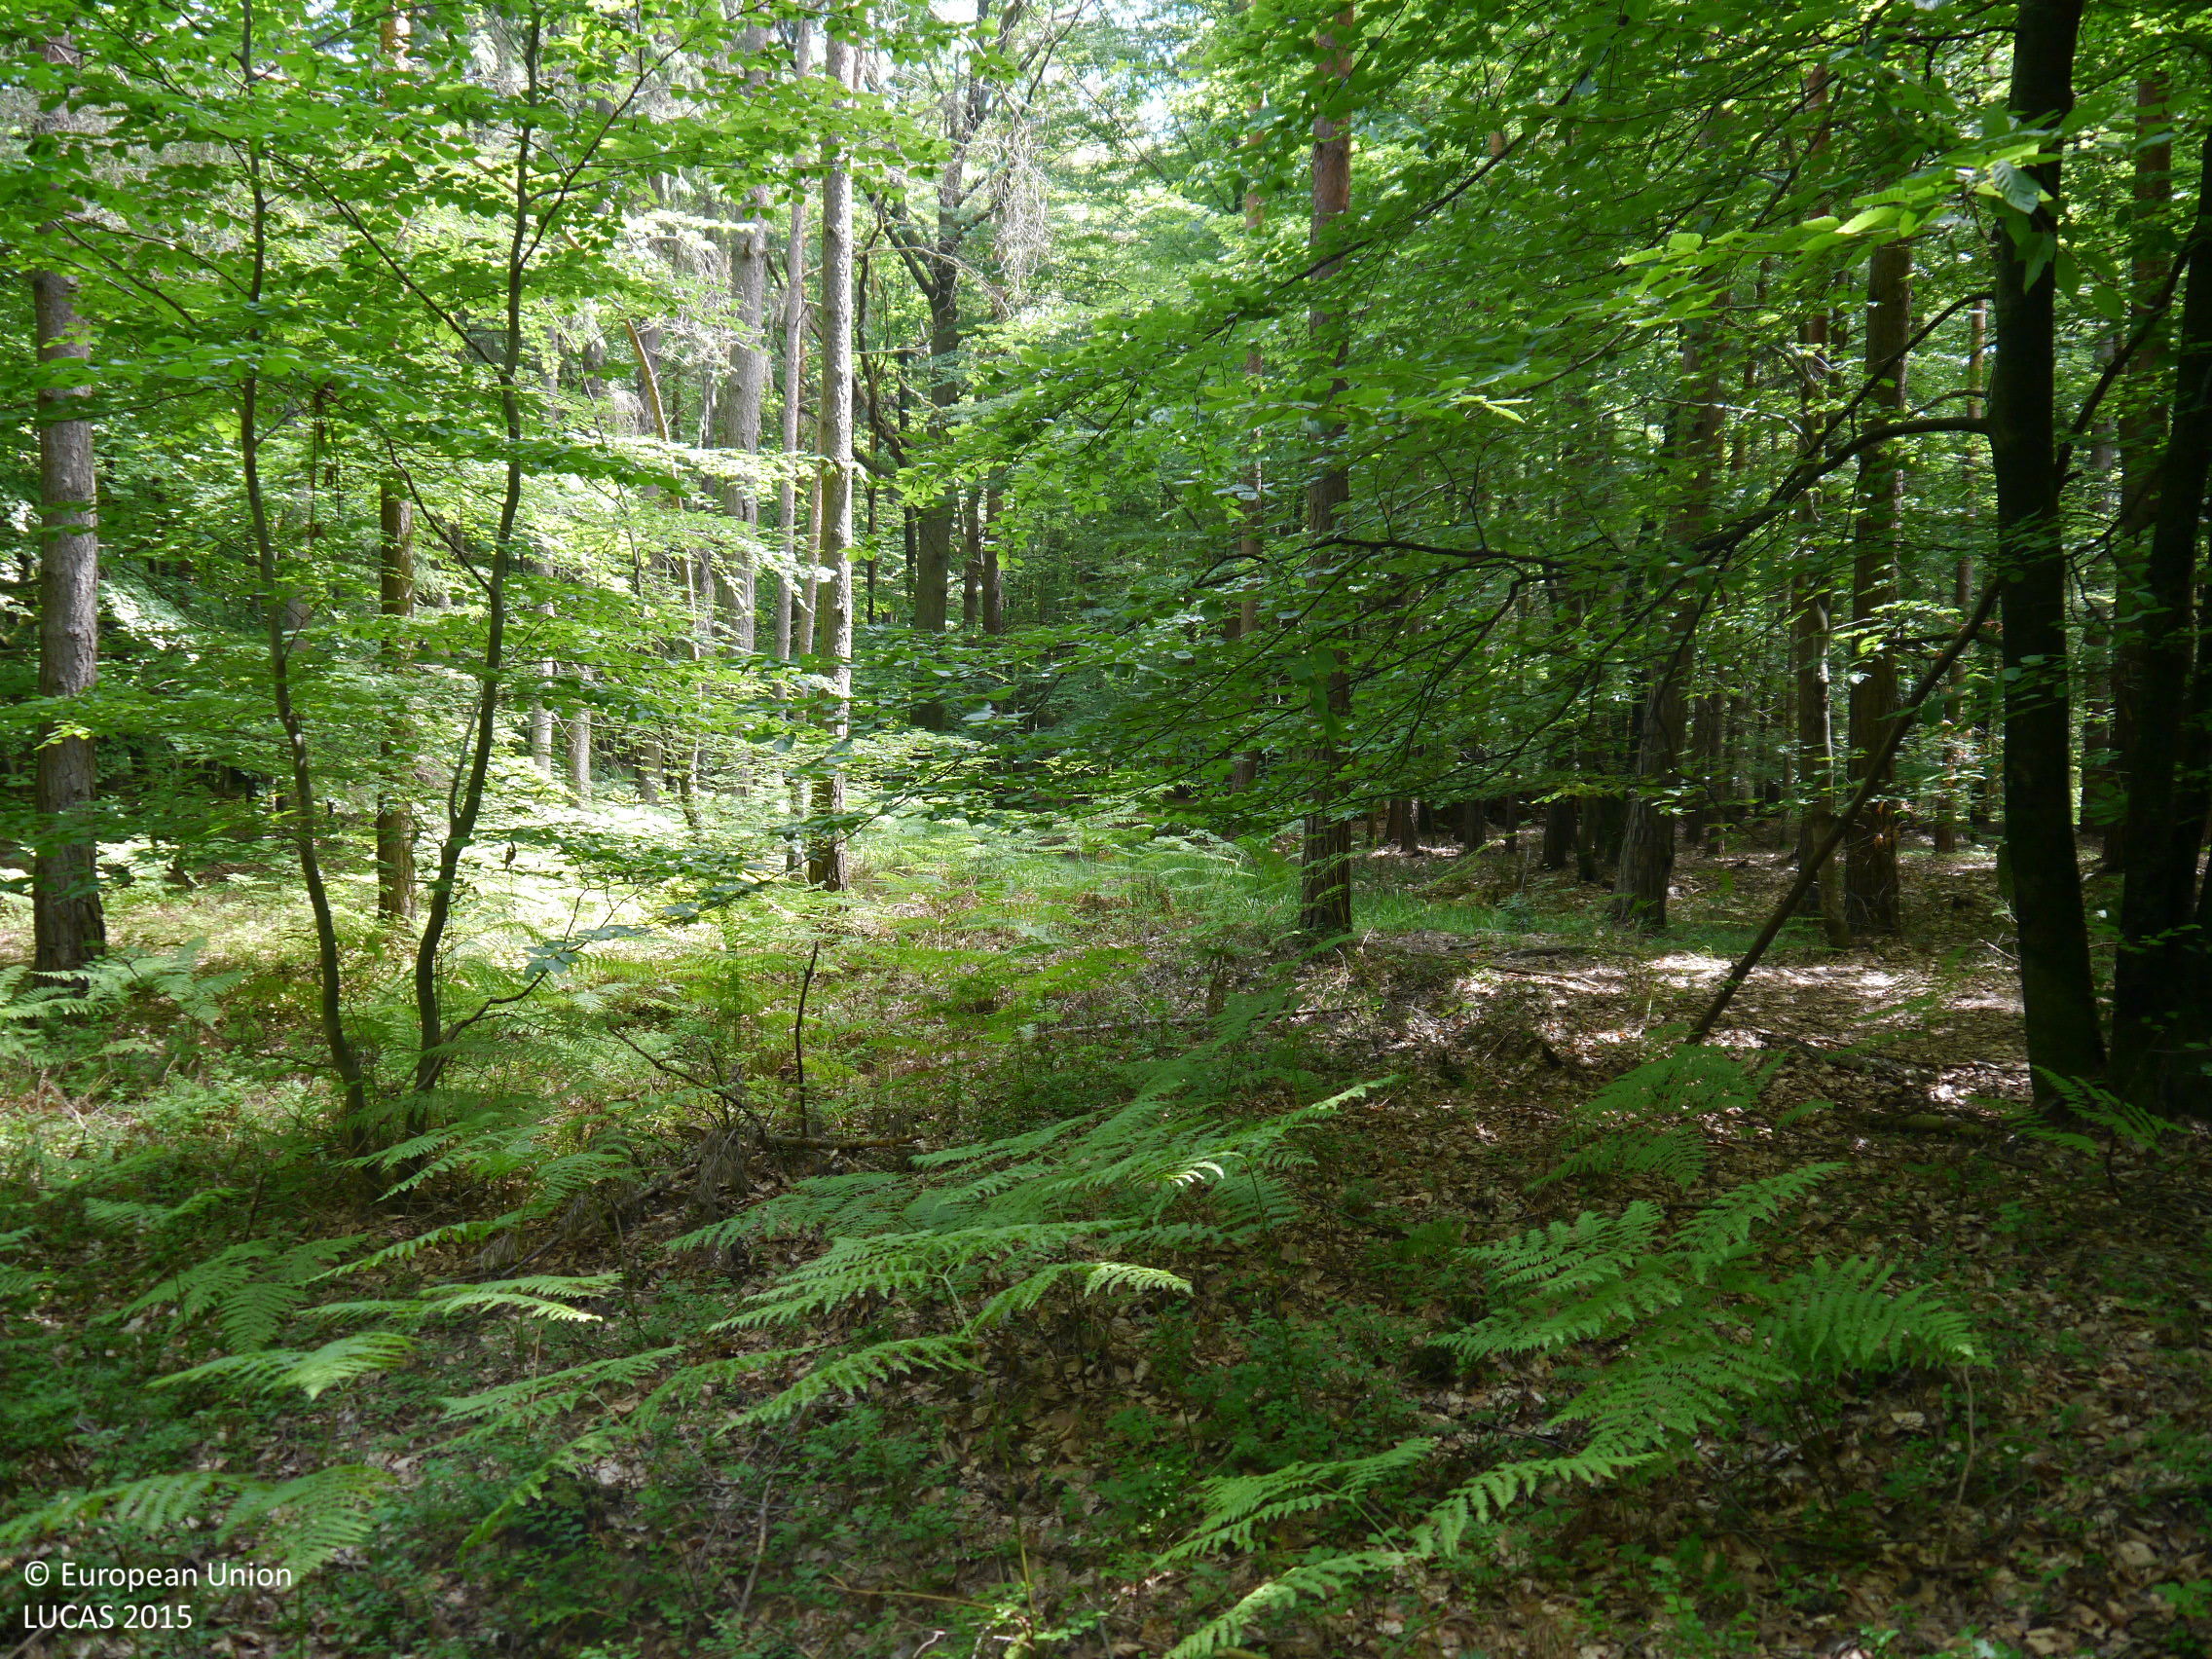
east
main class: Woodland
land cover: Pine dominated mixed woodland
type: hemiboreal forest and nemoral coniferous forest and mixed broadleaved-coniferous forest
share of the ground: > 75 %
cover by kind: broadleaved forest trees 50 %, coniferous forest trees 45 %, herbaceous plants 5 %
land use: Forestry
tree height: > 5 m
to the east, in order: Pine dominated mixed woodland; Tracks; Pine dominated mixed woodland; Tracks; Pine dominated mixed woodland; Tracks; Pine dominated mixed woodland
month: June
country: AT
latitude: 46.8668
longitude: 15.7066
